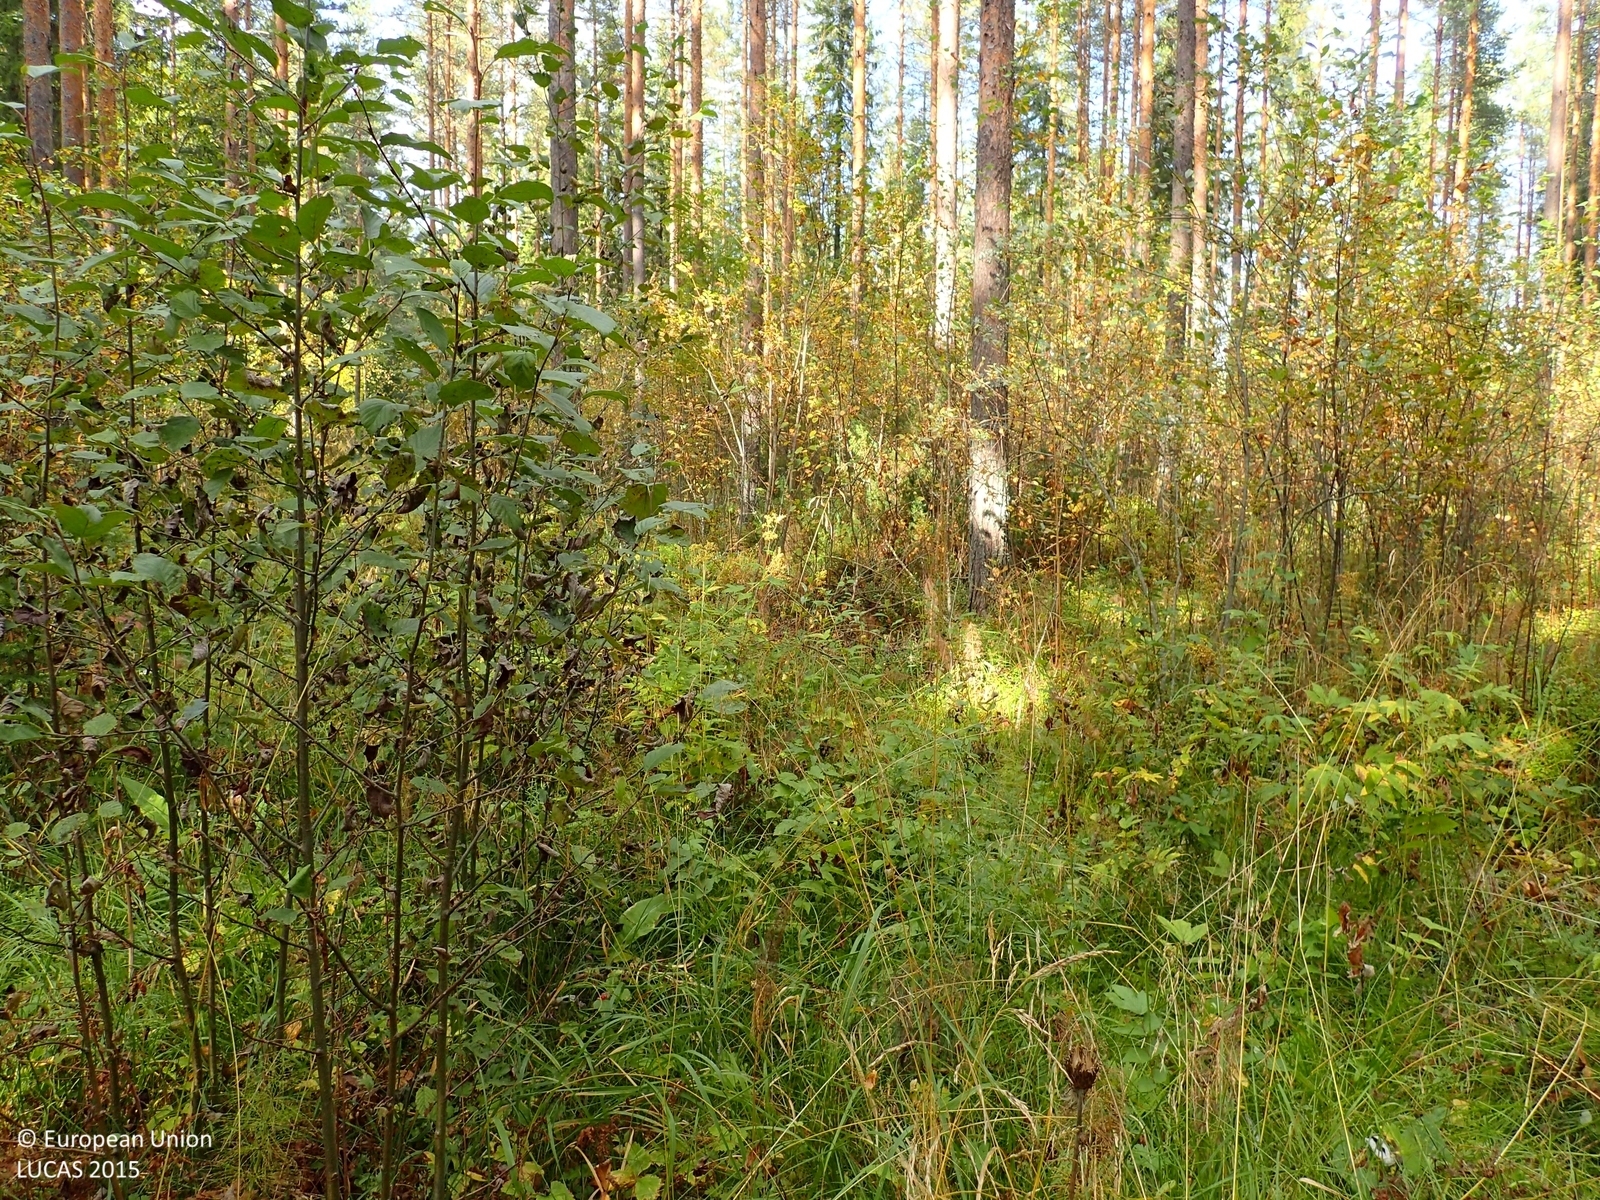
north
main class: Woodland
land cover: Pine dominated mixed woodland
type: boreal forest
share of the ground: > 75 %
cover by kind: coniferous forest trees 55 %, broadleaved forest trees 20 %, herbaceous plants 15 %, shrubs 10 %
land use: Forestry
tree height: > 5 m
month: September
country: FI
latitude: 63.0362
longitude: 25.3439
